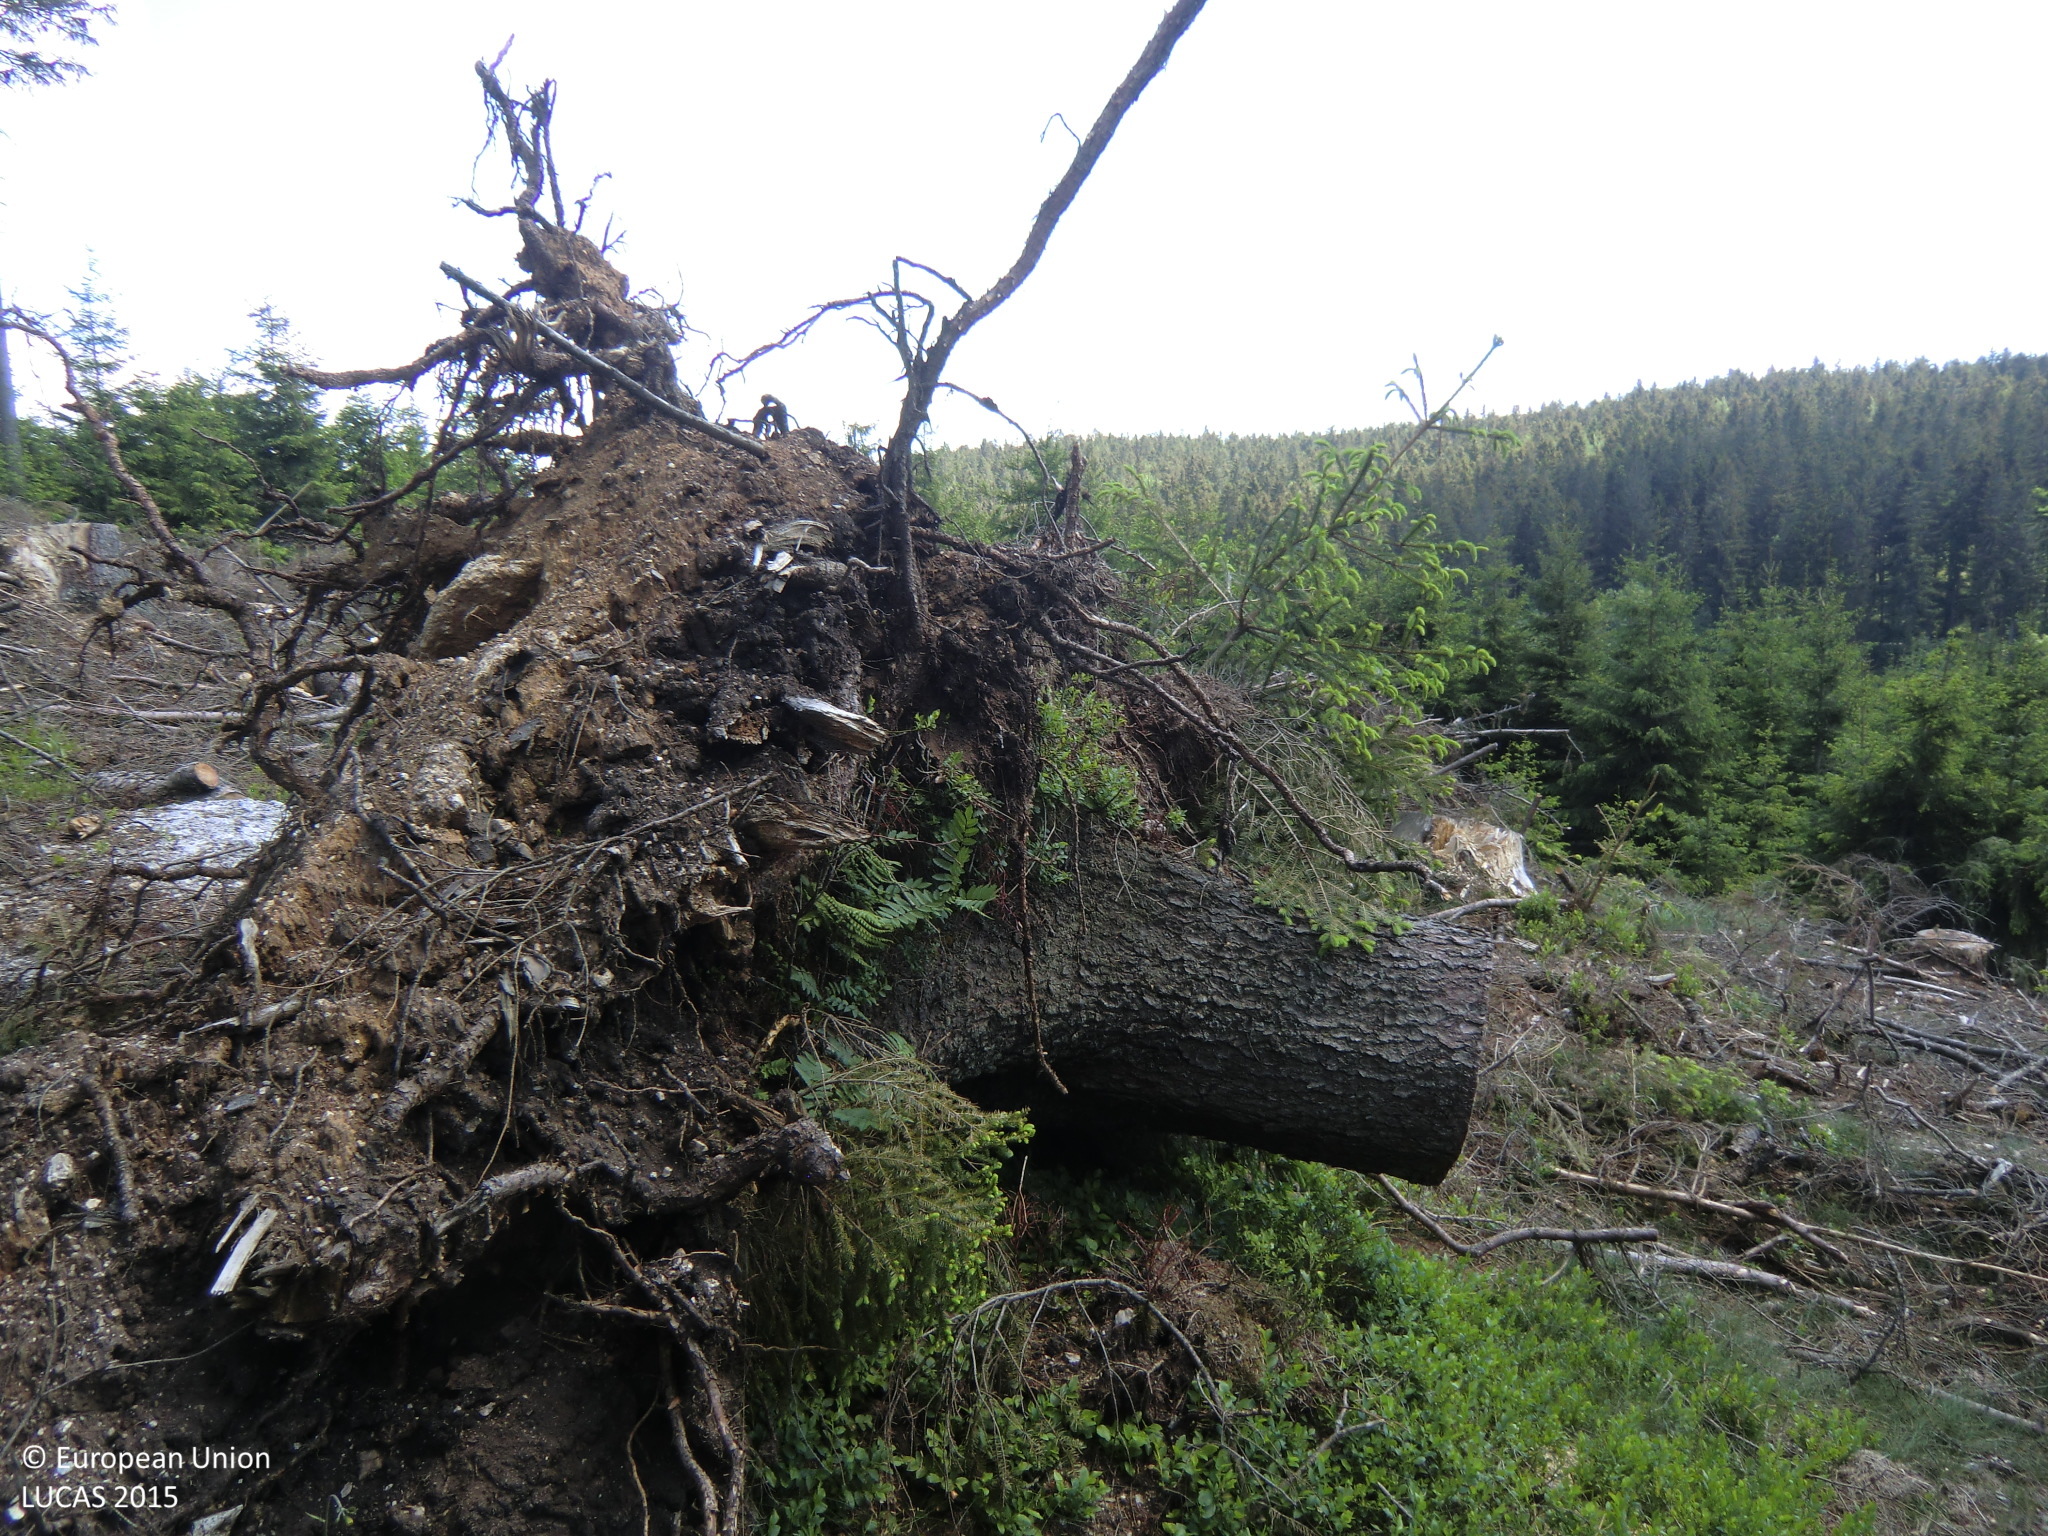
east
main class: Woodland
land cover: Spruce dominated coniferous woodland
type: hemiboreal forest and nemoral coniferous forest and mixed broadleaved-coniferous forest
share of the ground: > 75 %
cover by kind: coniferous forest trees 90 %, unconsolidated bare surface 10 %
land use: Forestry
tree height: > 5 m
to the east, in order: Spruce dominated coniferous woodland; Shrubland with sparse tree cover; Spruce dominated coniferous woodland; Tracks; Spruce dominated coniferous woodland; Tracks; Spruce dominated coniferous woodland
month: June
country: AT
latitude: 48.3776
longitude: 15.0645
